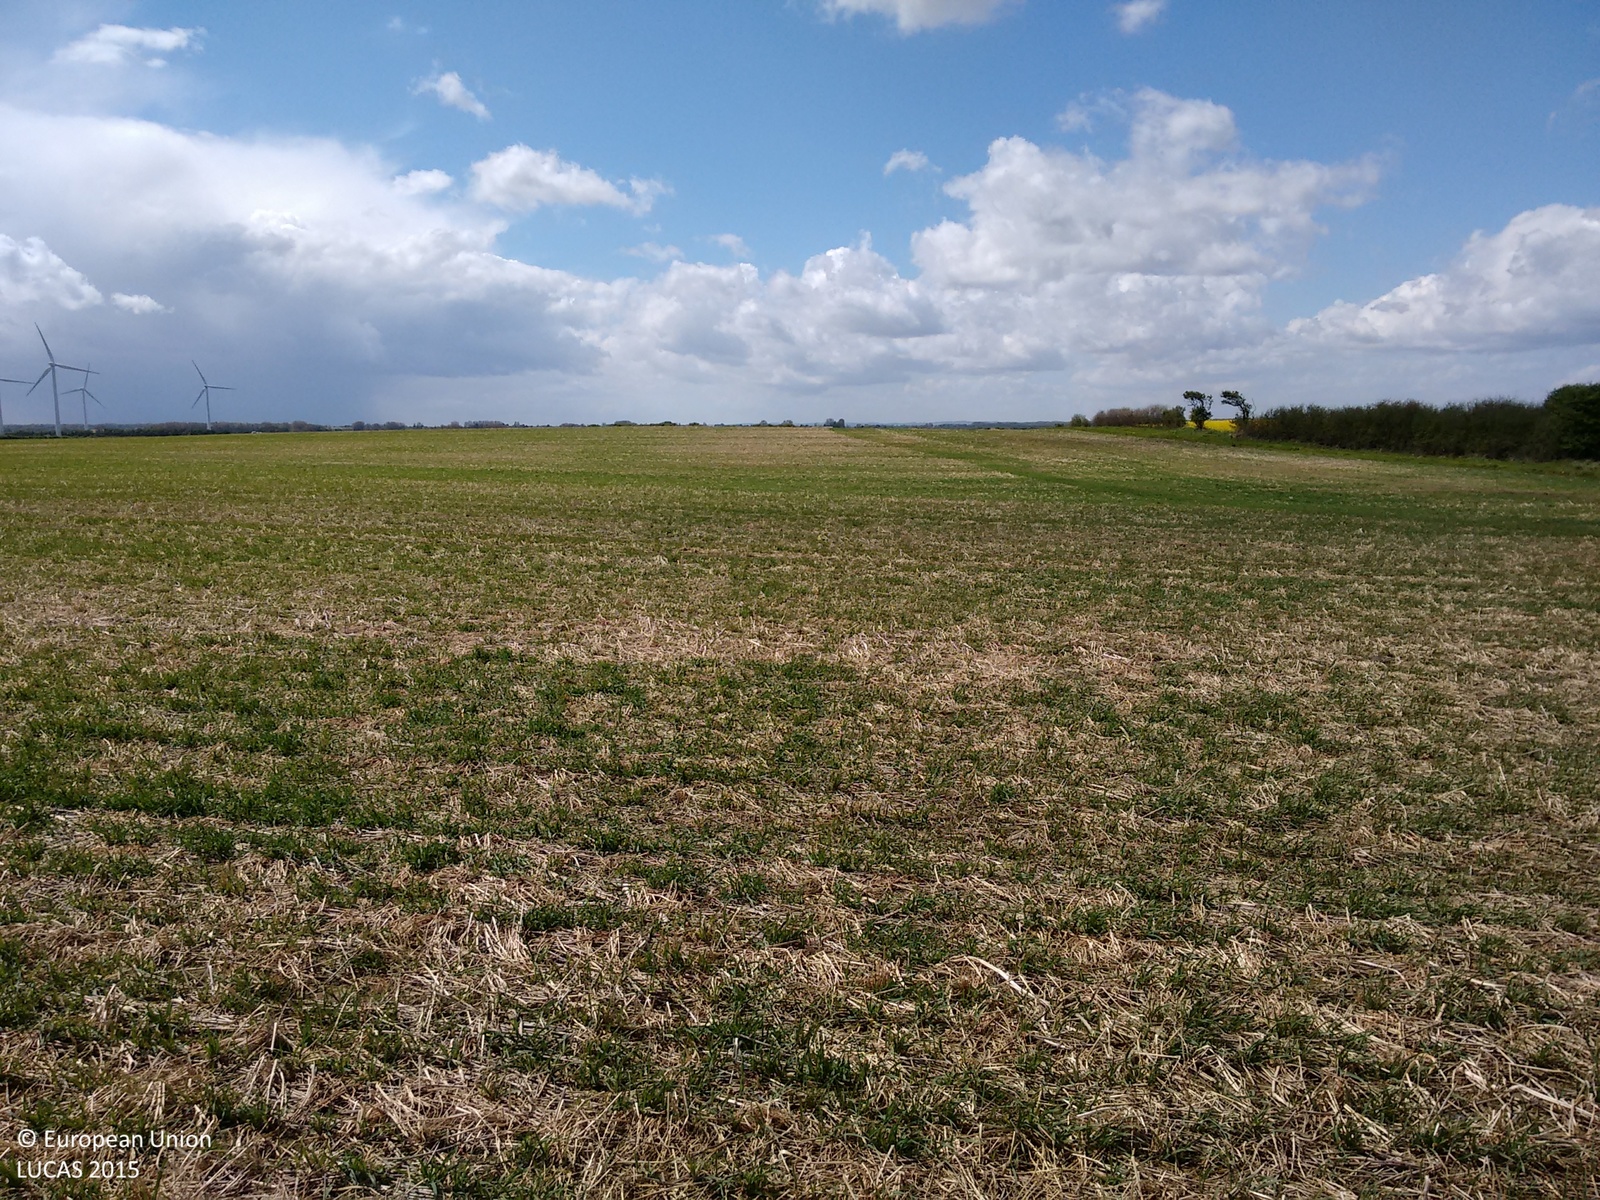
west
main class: Cropland
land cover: Barley
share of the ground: 25 - 50 %
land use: Agriculture (excluding fallow land and kitchen gardens)
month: May
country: GB
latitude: 53.8630
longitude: -0.1446
